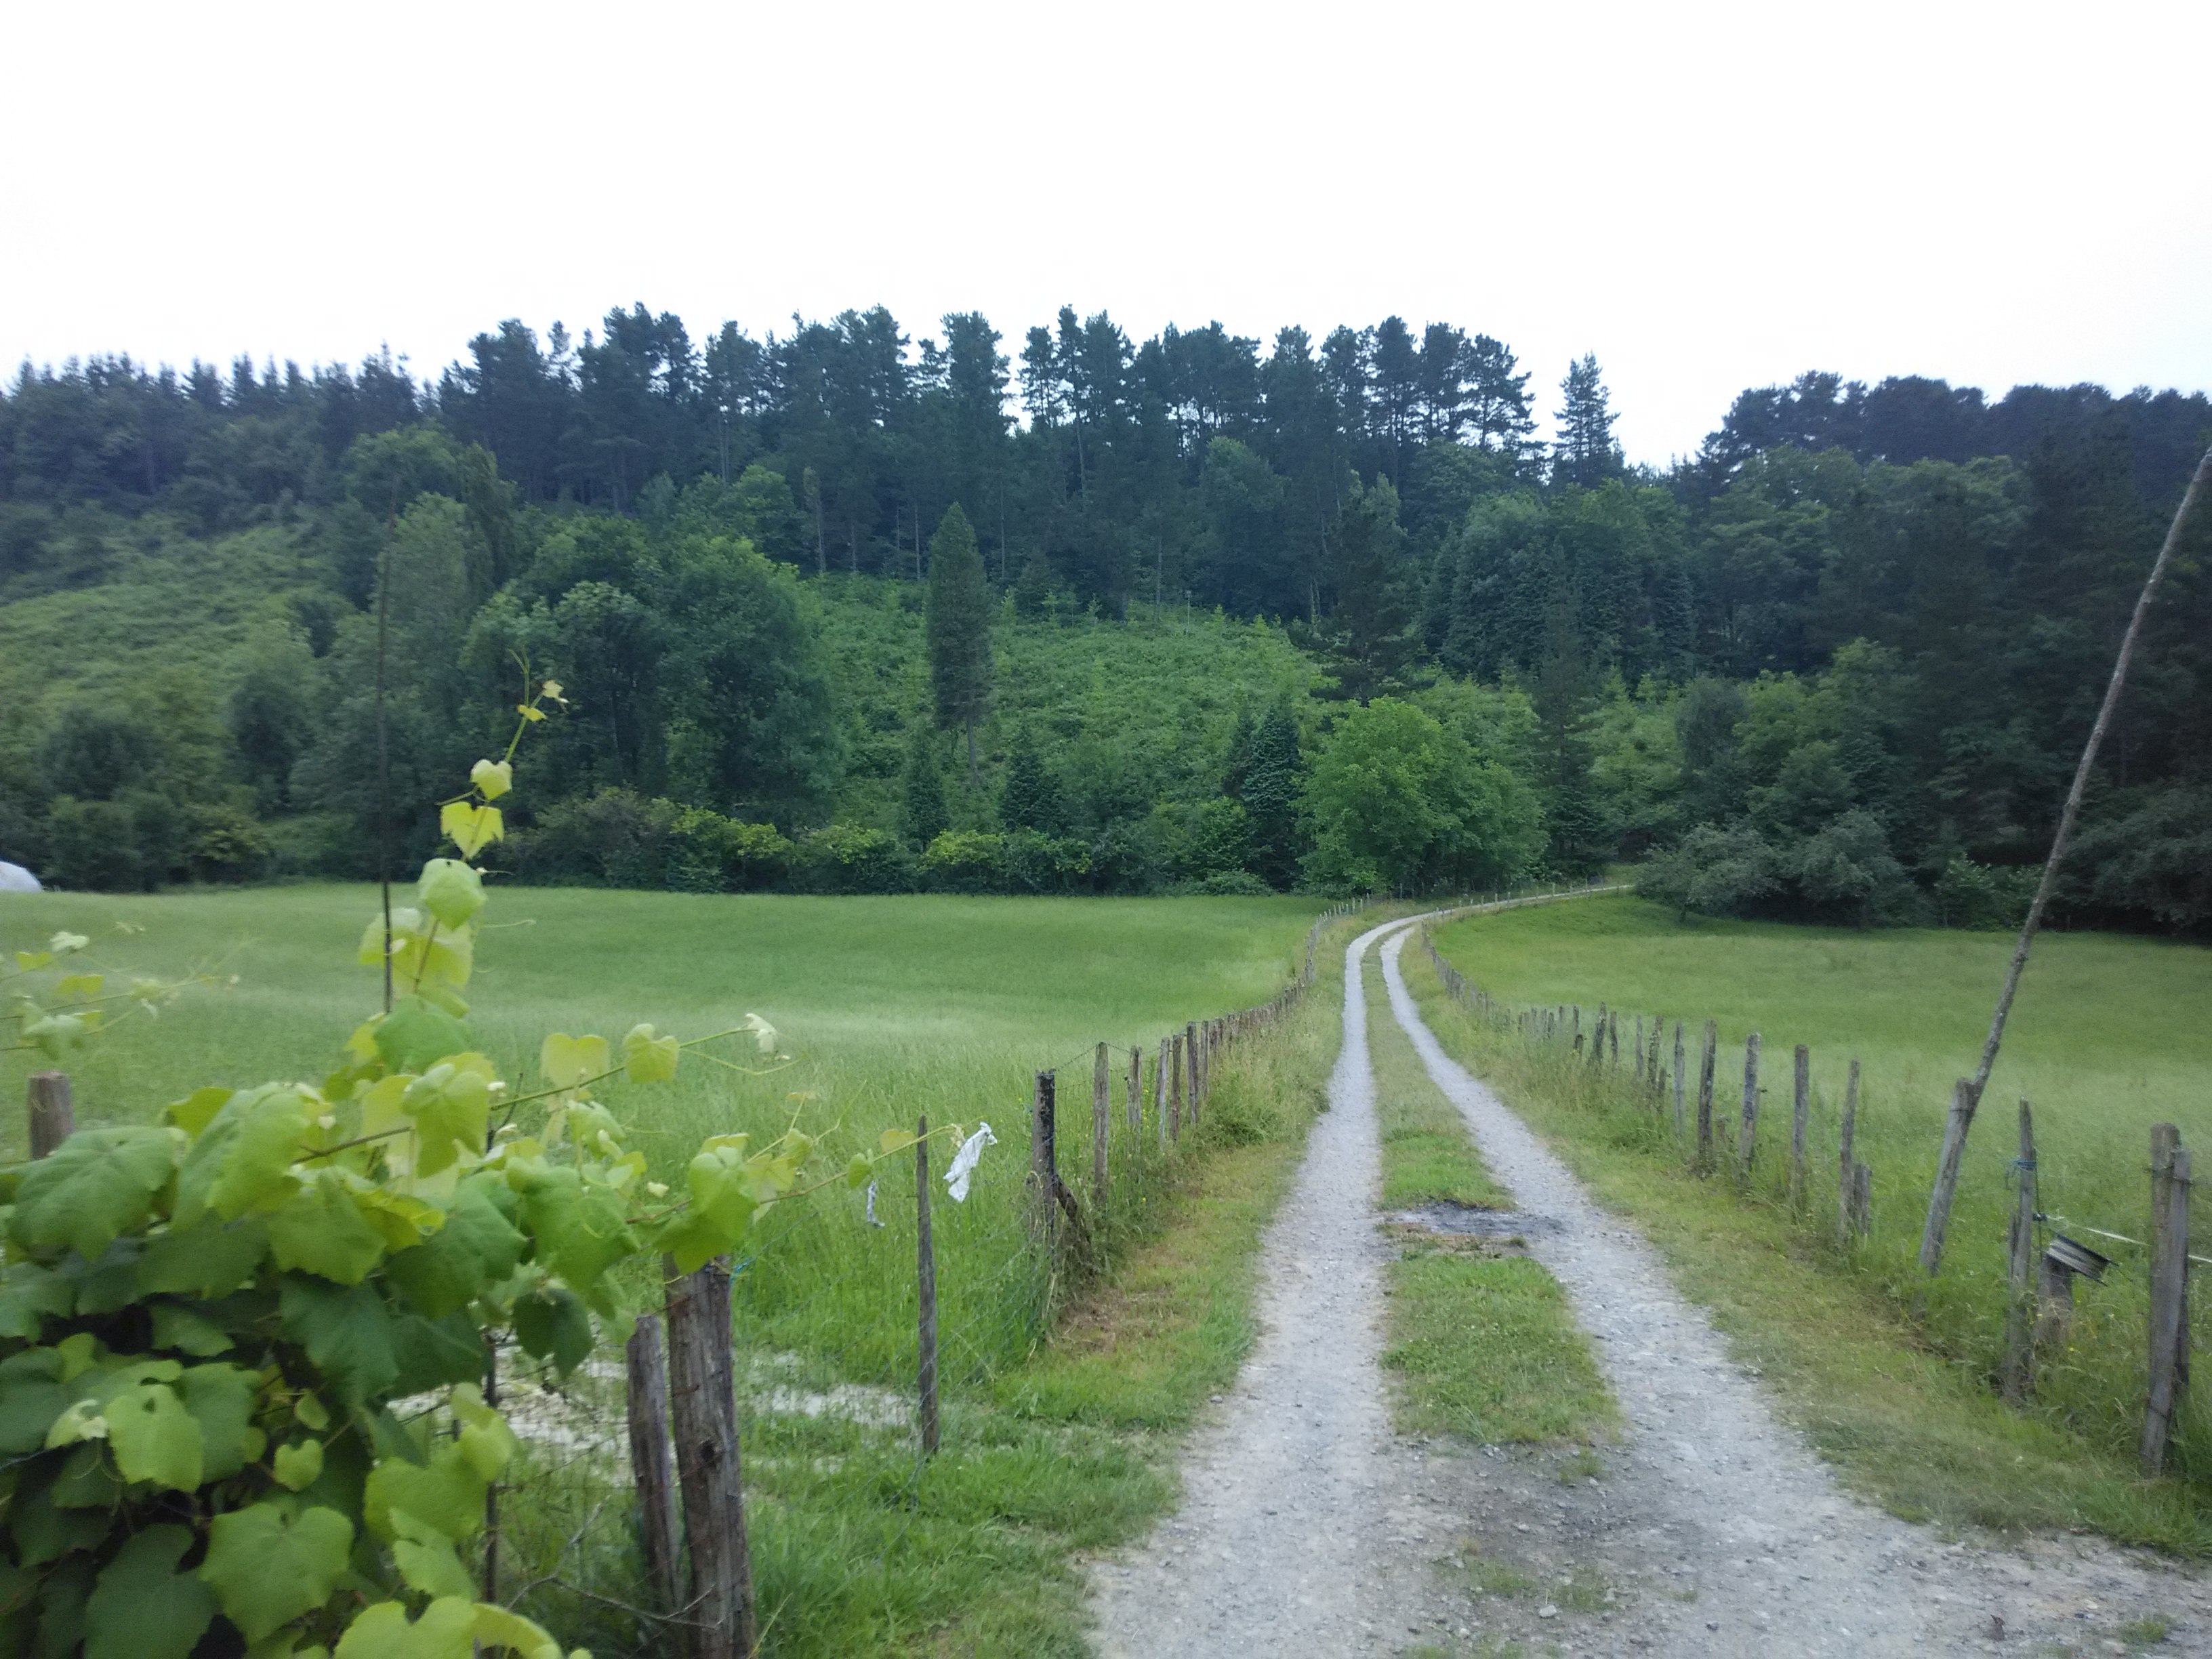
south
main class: Grassland
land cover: Grassland with sparse tree/shrub cover
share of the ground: 25 - 50 %
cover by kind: herbaceous plants 60 %, broadleaved forest trees 5 %, shrubs 5 %
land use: Agriculture (excluding fallow land and kitchen gardens)
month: June
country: ES
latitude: 43.1791
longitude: -2.5896
